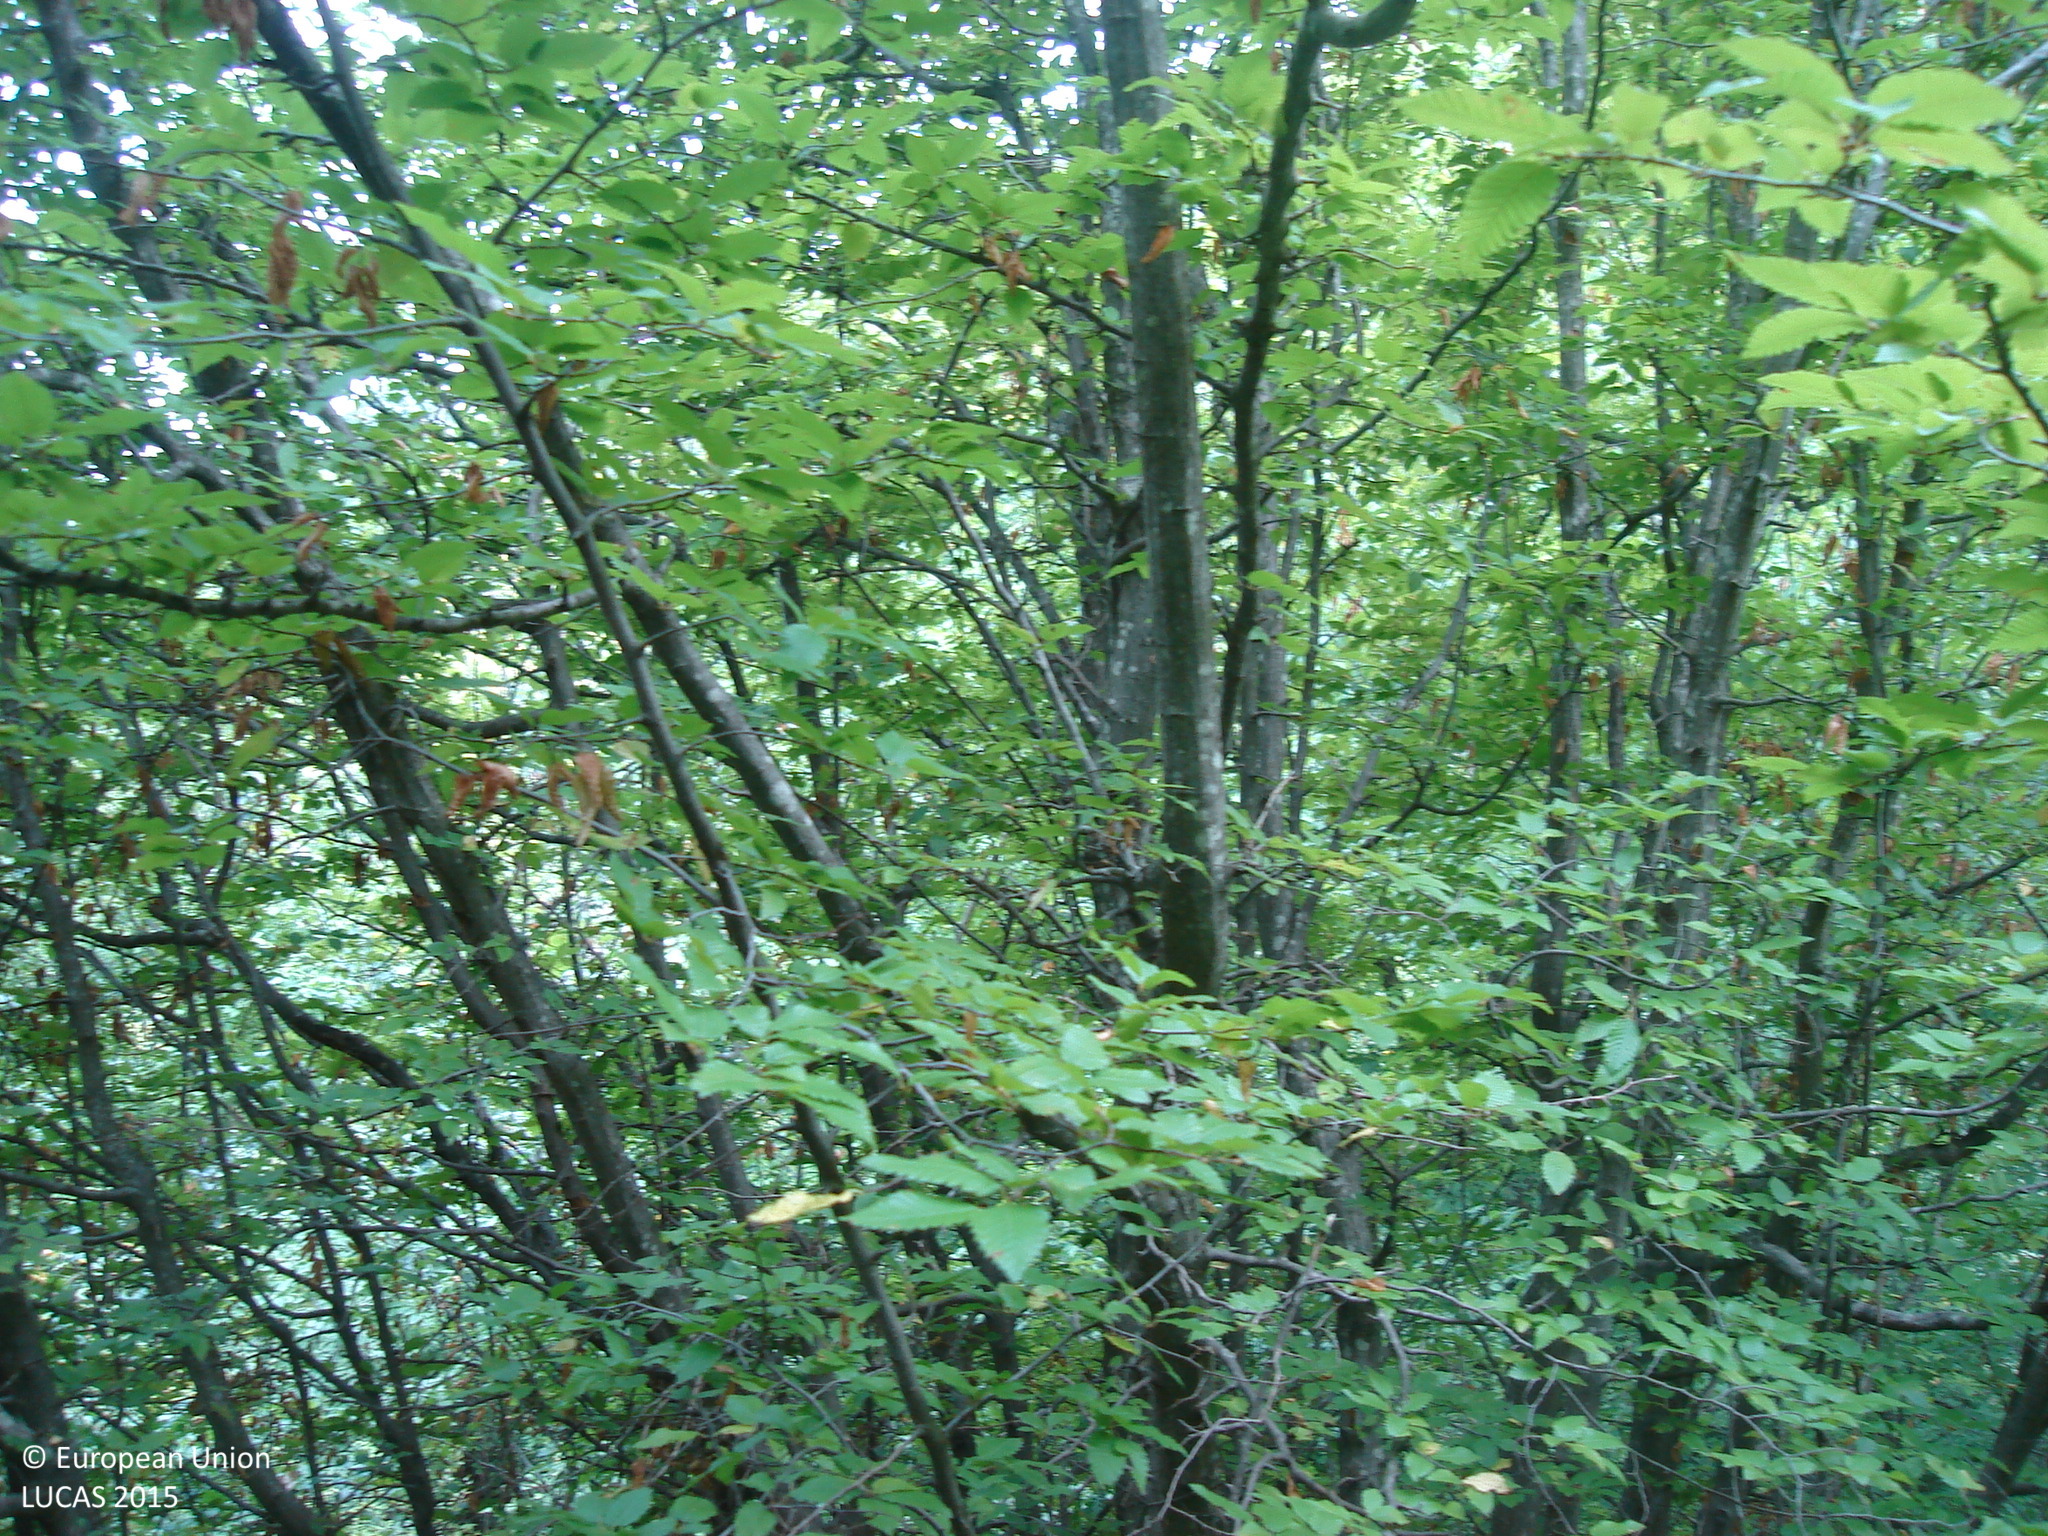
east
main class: Woodland
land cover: Broadleaved woodland
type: thermophilous deciduous forest
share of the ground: > 75 %
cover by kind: broadleaved forest trees 95 %, consolidated bare surface 5 %
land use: Forestry
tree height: > 5 m
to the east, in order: Broadleaved woodland; Tracks; Broadleaved woodland; Grassland with sparse tree/shrub cover
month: September
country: BG
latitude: 43.0861
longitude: 23.3168
